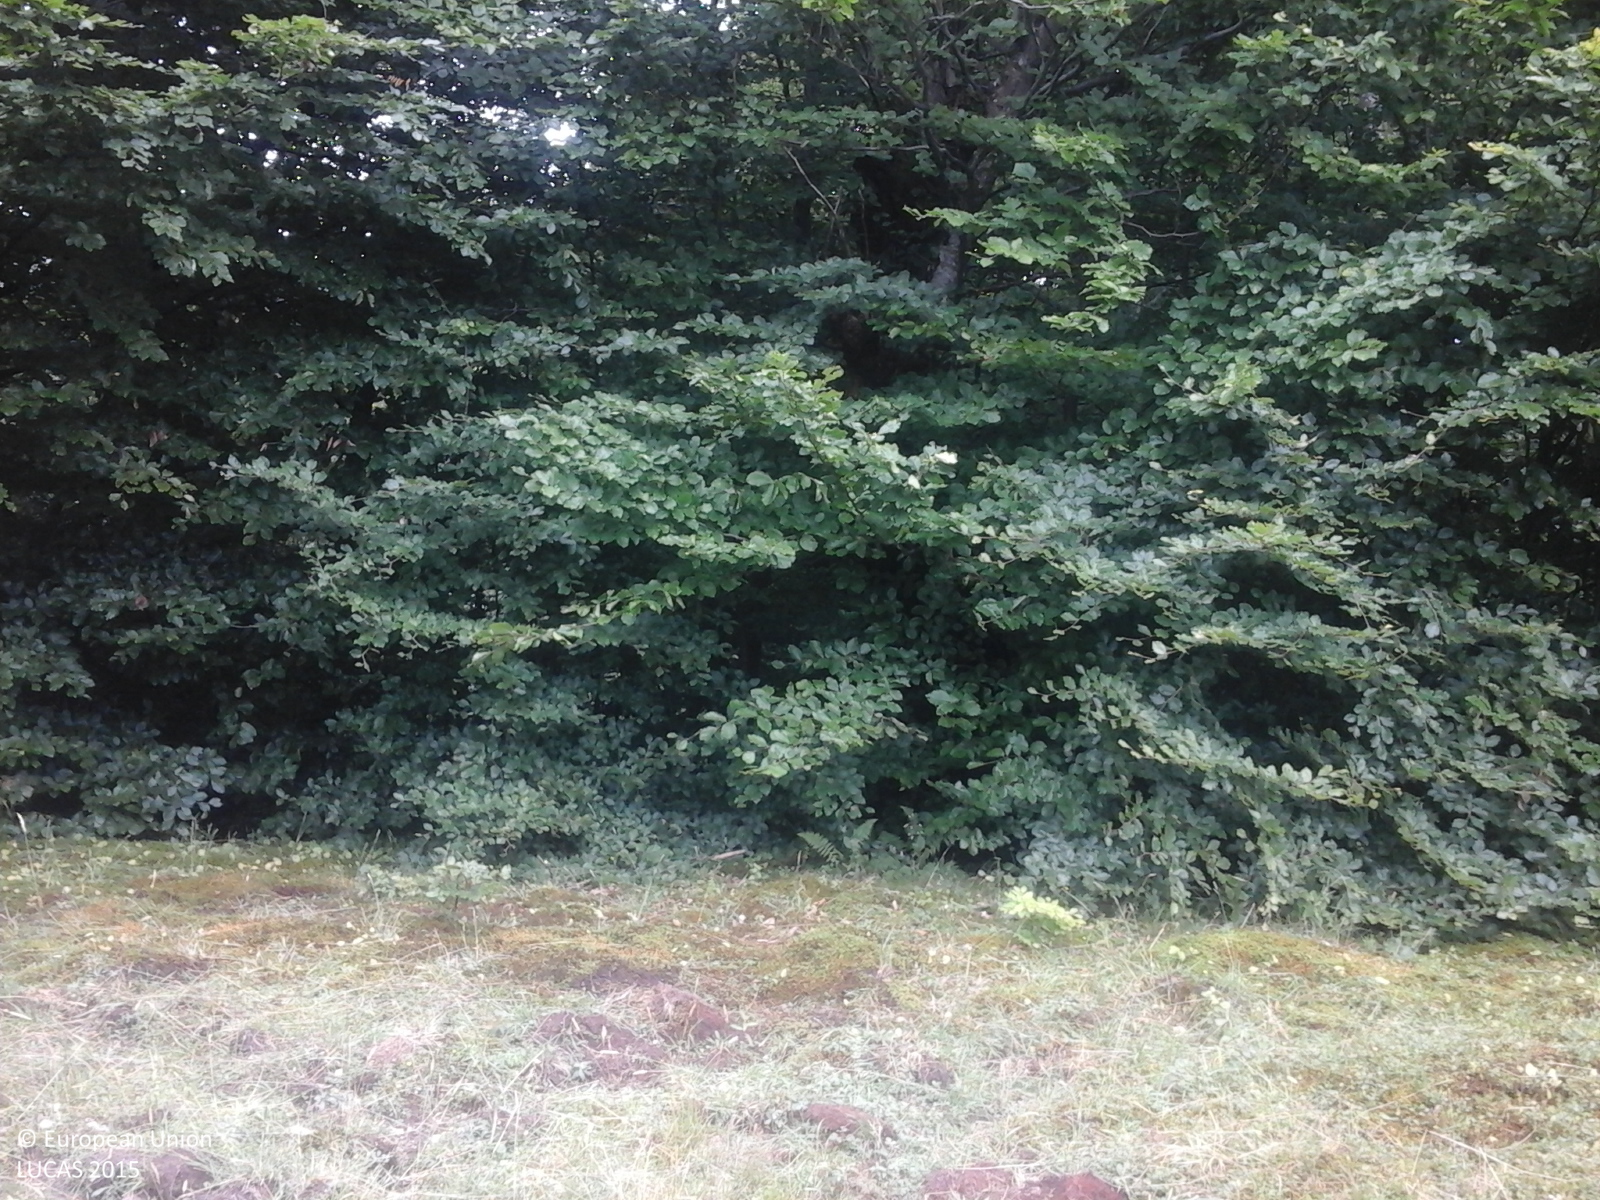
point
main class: Woodland
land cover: Broadleaved woodland
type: beech forest
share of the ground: > 75 %
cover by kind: broadleaved forest trees 100 %
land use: Forestry
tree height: > 5 m
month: July
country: RO
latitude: 45.3510
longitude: 24.8013
